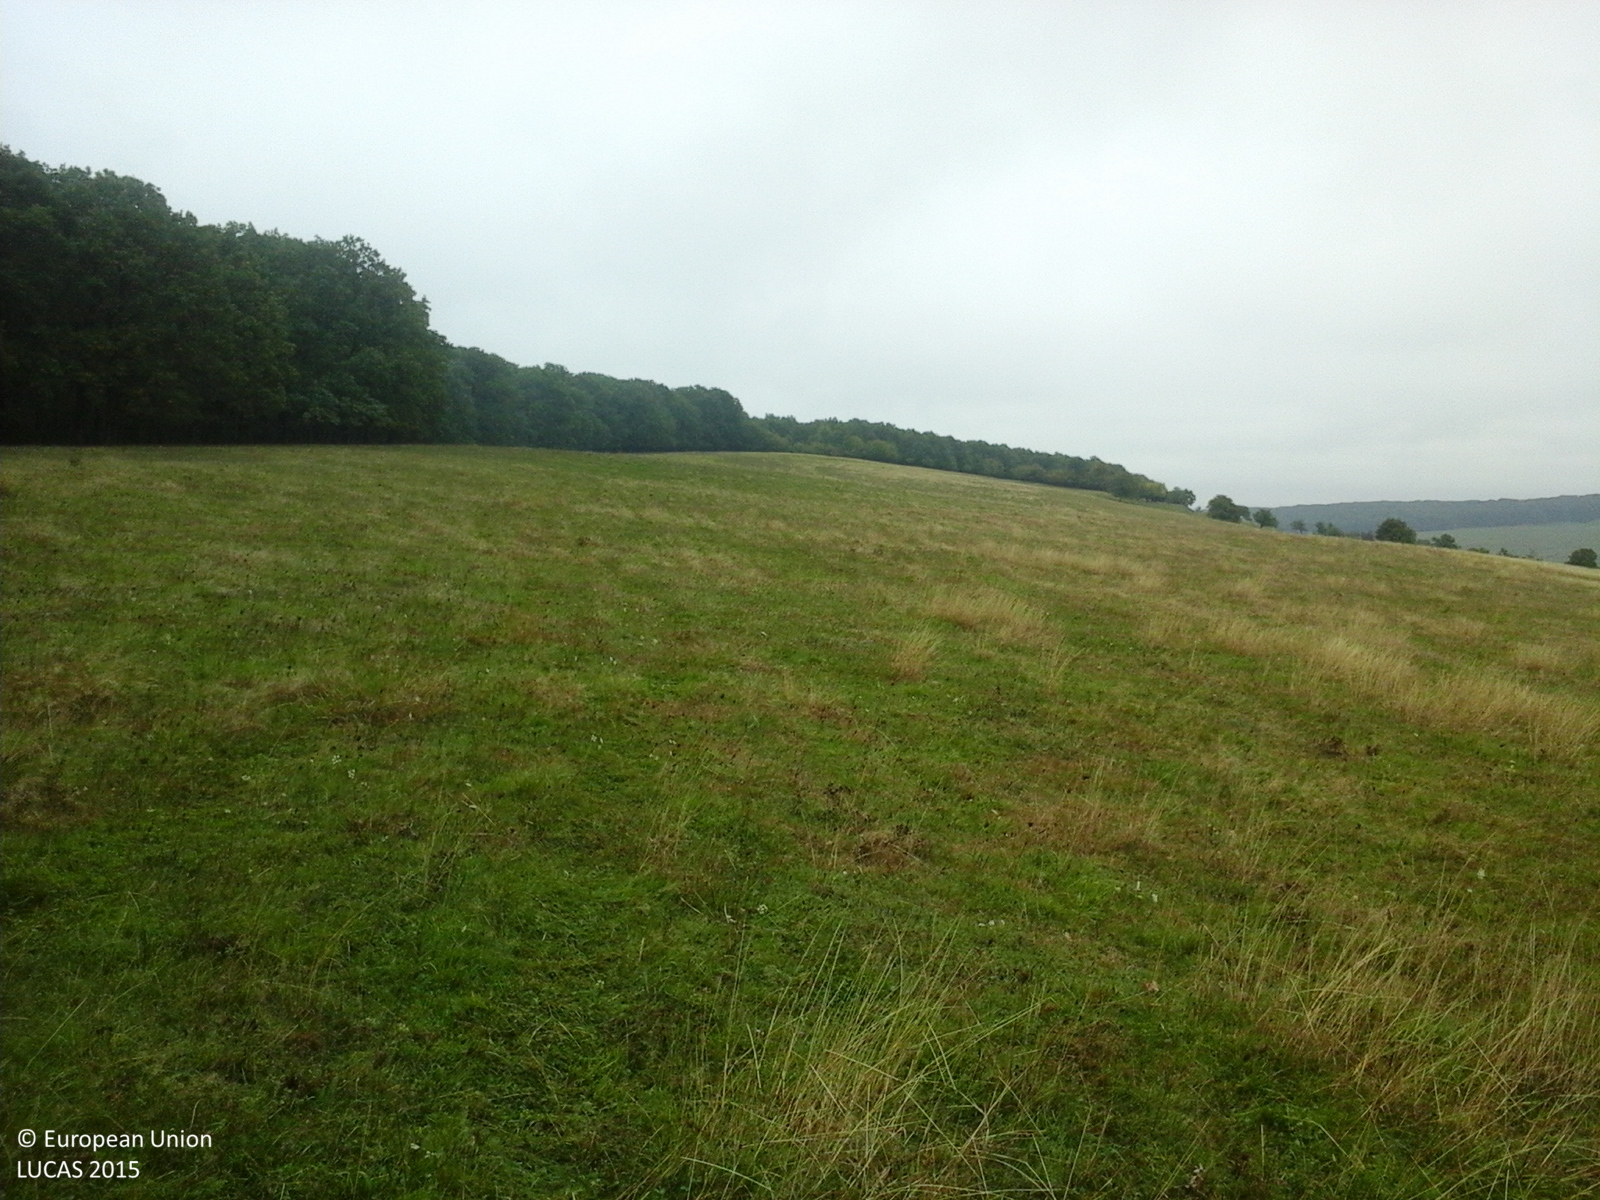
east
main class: Grassland
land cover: Grassland without tree/shrub cover
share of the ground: > 75 %
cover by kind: herbaceous plants 100 %
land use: Agriculture (excluding fallow land and kitchen gardens)
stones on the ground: < 10 %
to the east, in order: Grassland without tree/shrub cover
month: October
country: RO
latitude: 45.8075
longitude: 24.0082
